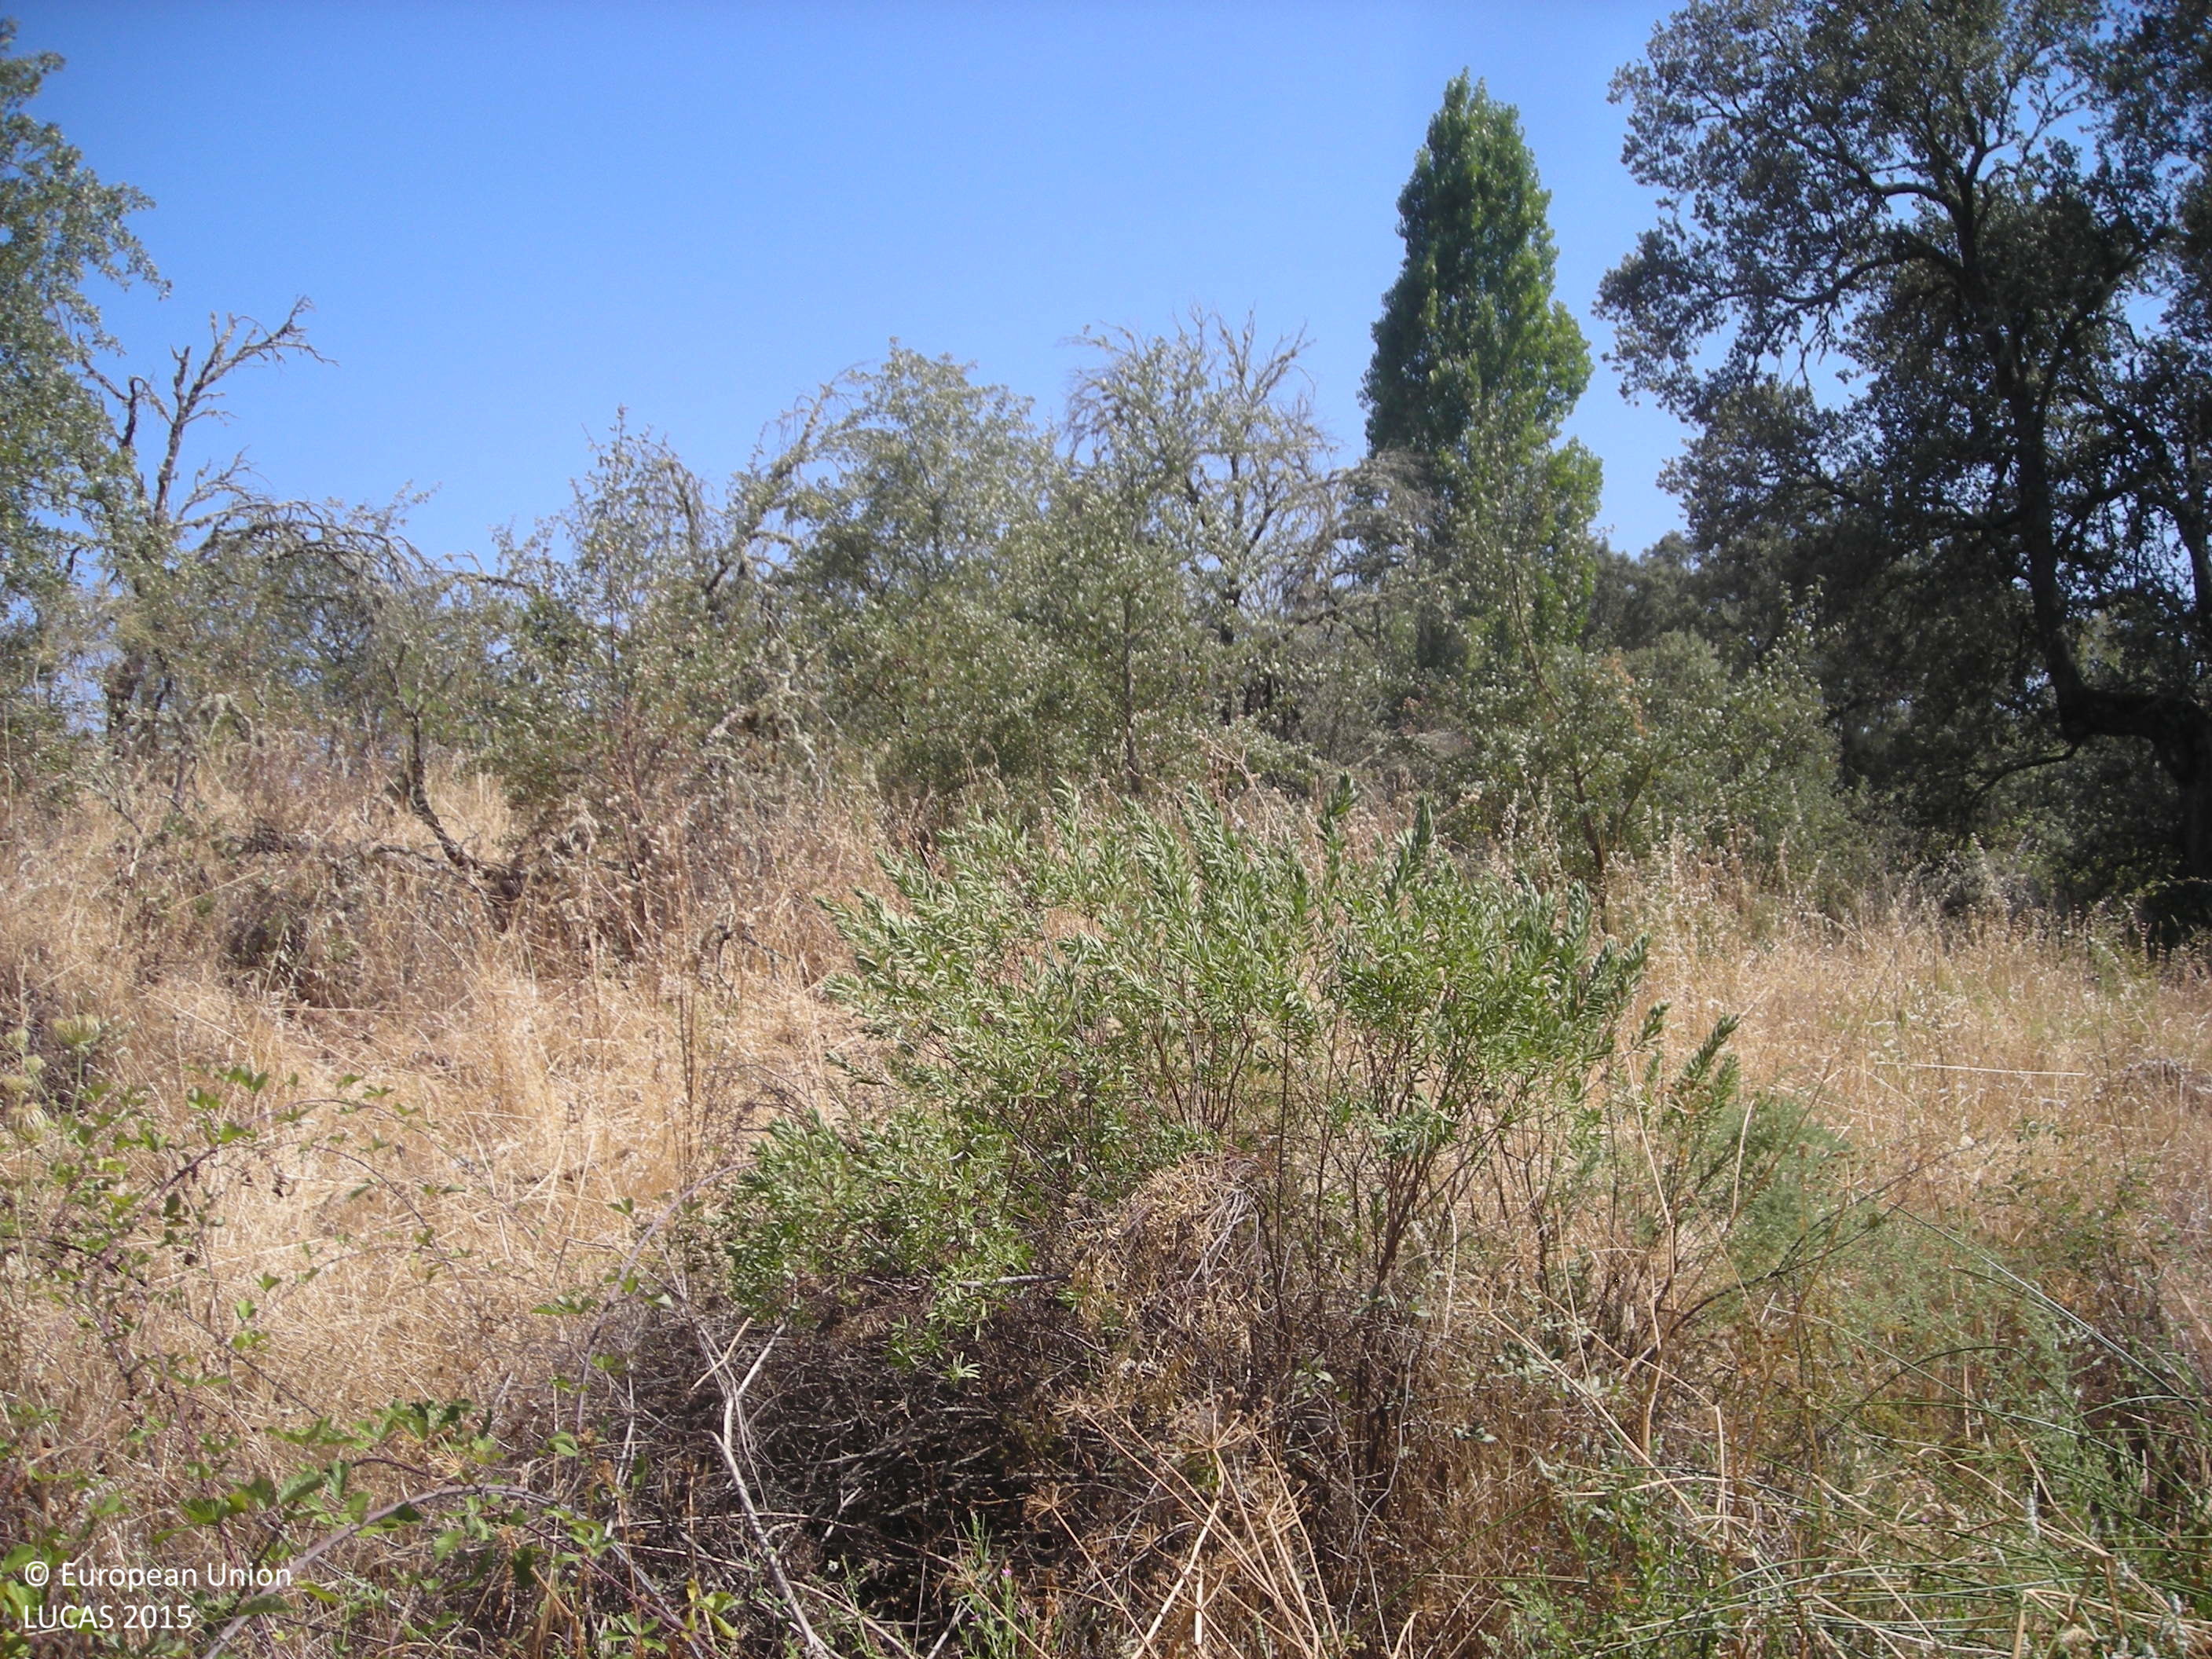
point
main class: Woodland
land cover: Broadleaved woodland
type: broadleaved evergreen forest
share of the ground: 10 - 25 %
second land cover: Grassland without tree/shrub cover
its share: > 75 %
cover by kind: herbaceous plants 90 %, broadleaved forest trees 10 %
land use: Forestry
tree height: > 5 m
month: July
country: ES
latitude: 38.6716
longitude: -5.8715
